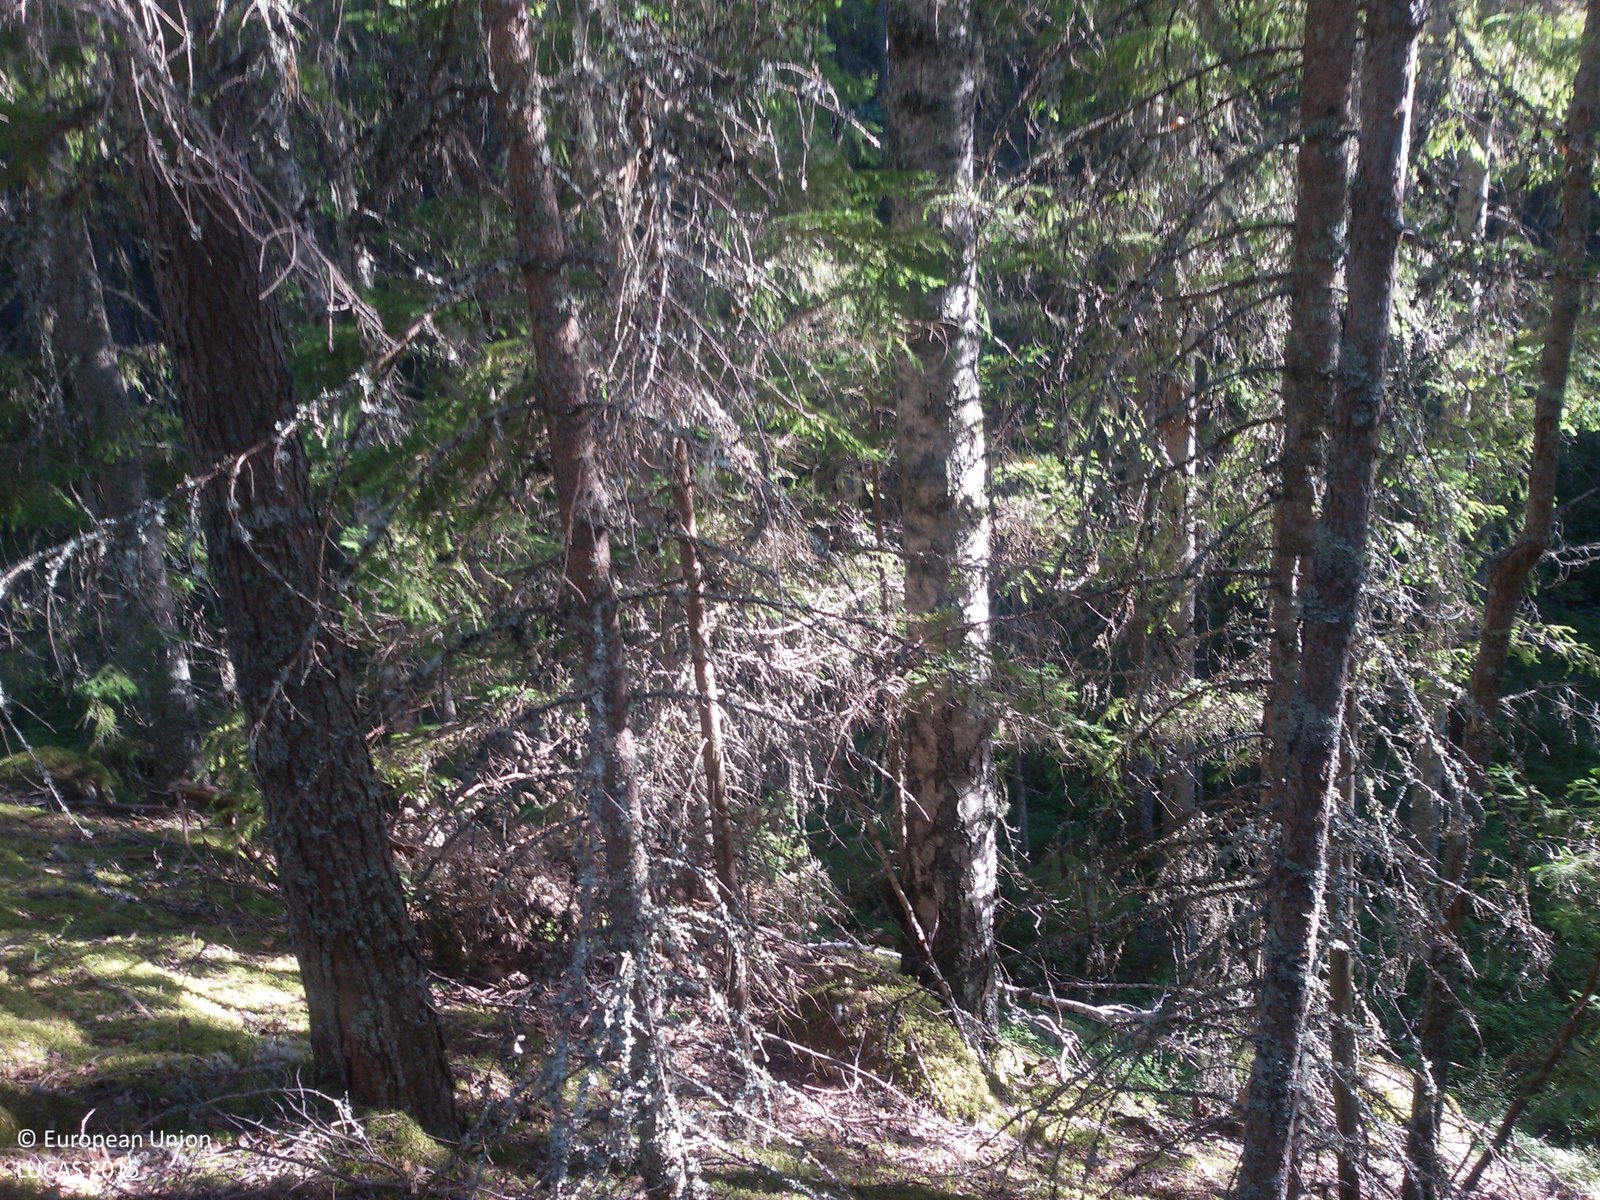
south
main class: Woodland
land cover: Spruce dominated coniferous woodland
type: boreal forest
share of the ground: 50 - 75 %
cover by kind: coniferous forest trees 65 %, lichens and mosses 20 %, herbaceous plants 10 %, broadleaved forest trees 5 %
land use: Amenities, museums, leisure
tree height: > 5 m
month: August
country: SE
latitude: 60.7374
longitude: 16.4614
